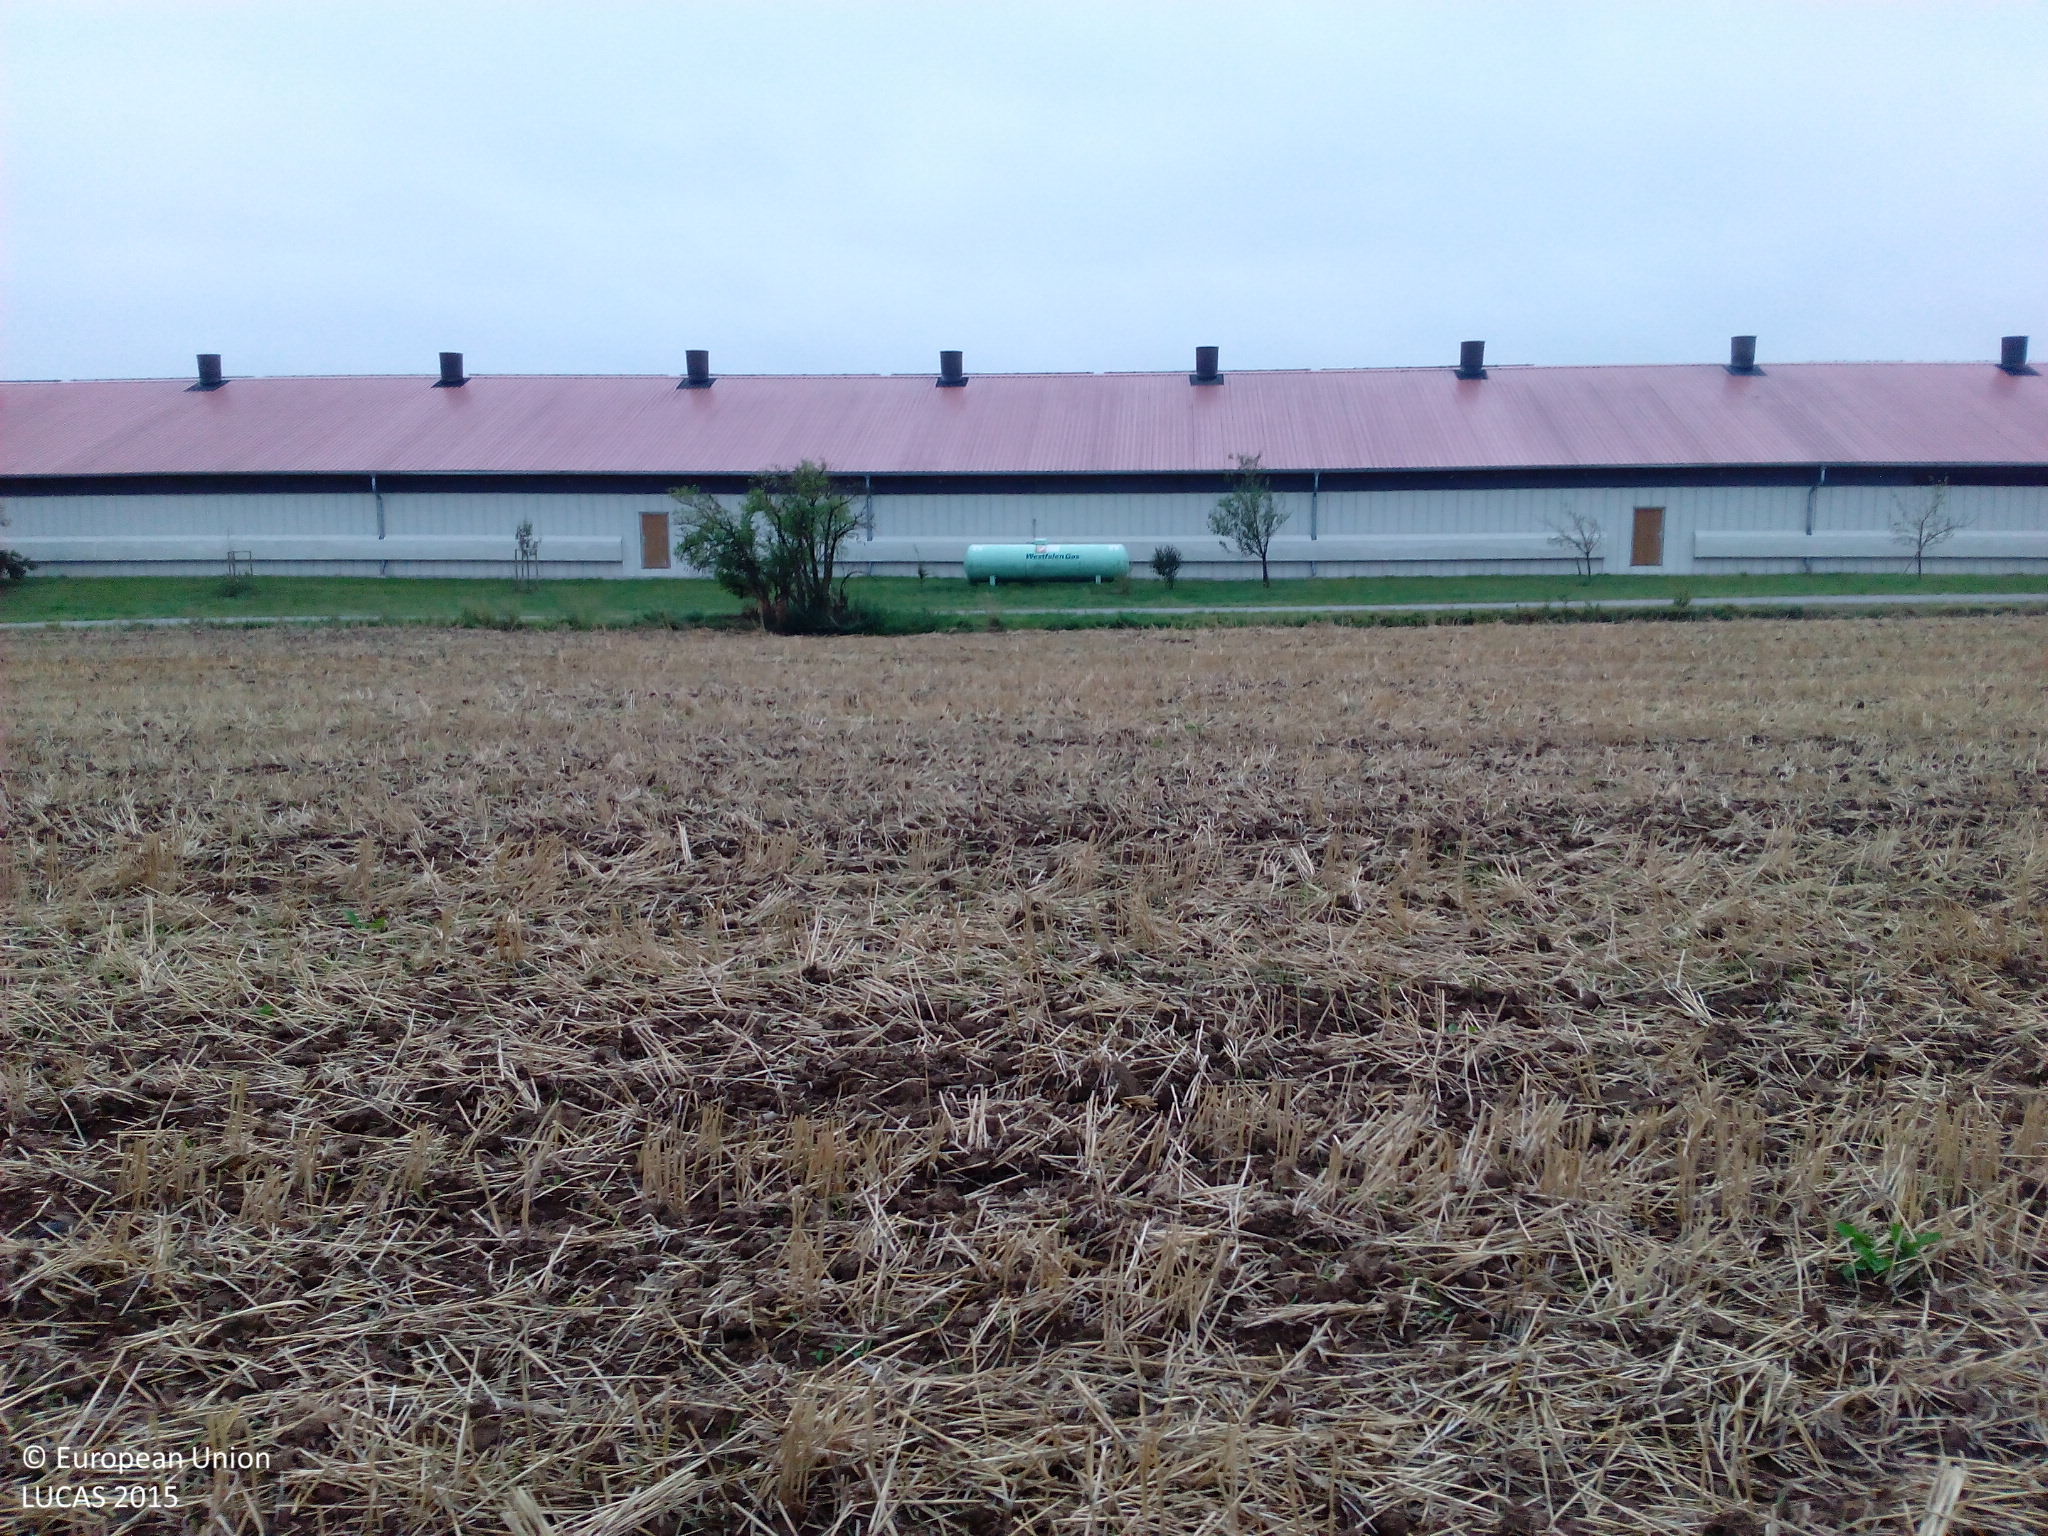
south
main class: Cropland
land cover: Common wheat
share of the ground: 25 - 50 %
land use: Agriculture (excluding fallow land and kitchen gardens)
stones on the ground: < 10 %
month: August
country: DE
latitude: 48.4934
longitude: 9.9594
